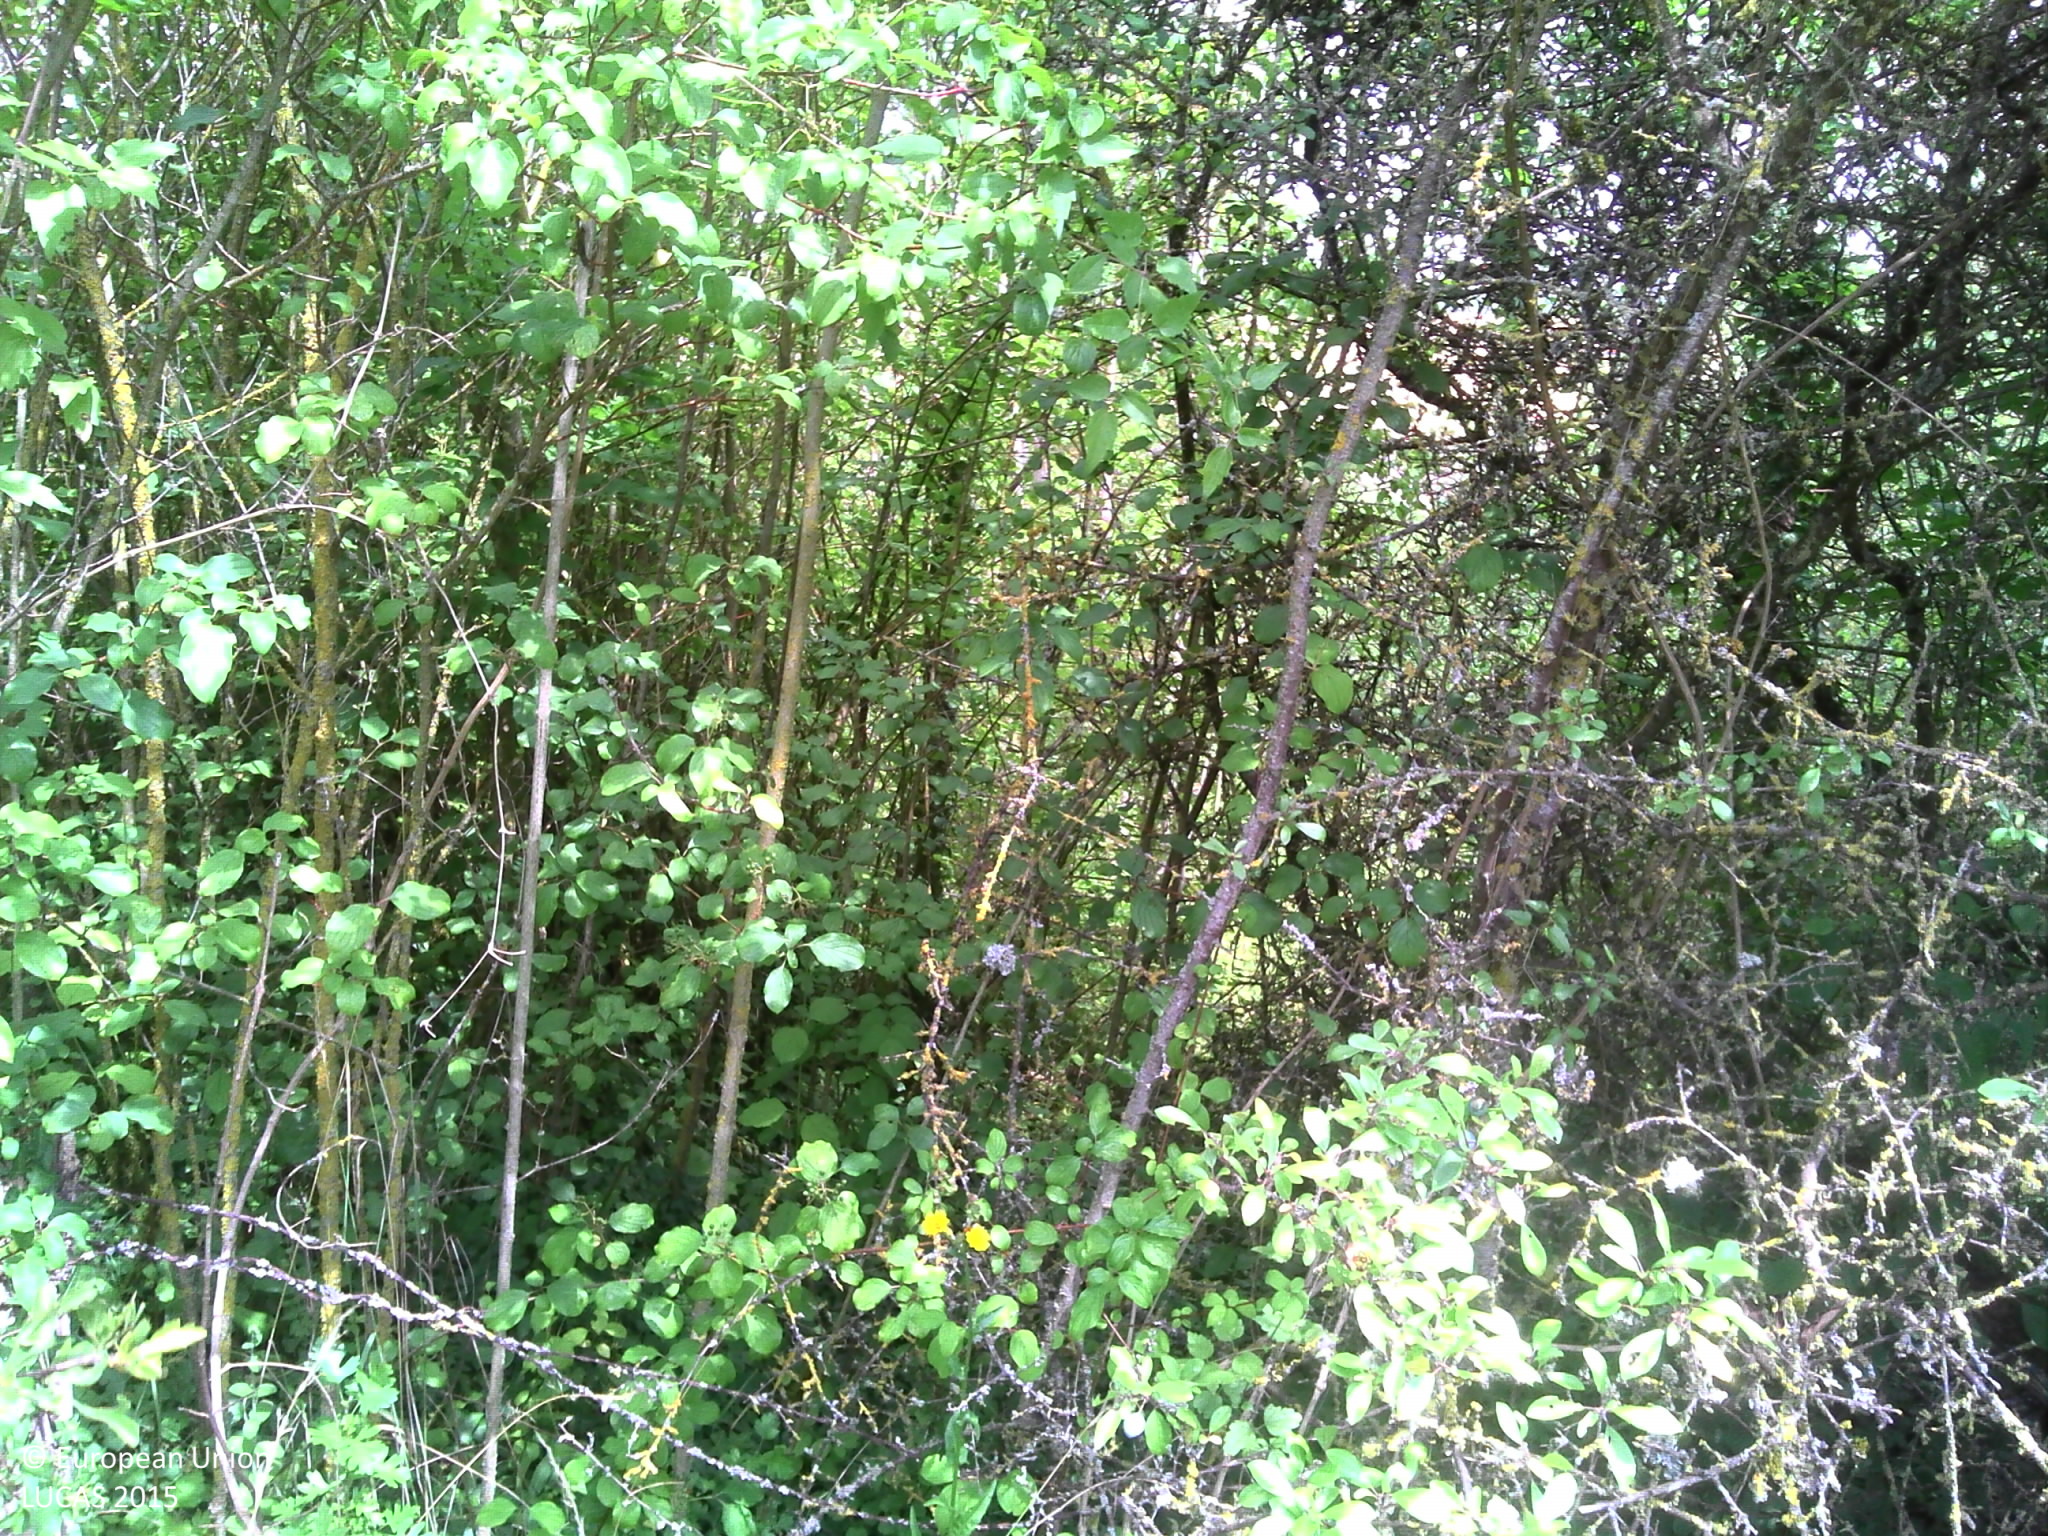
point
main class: Grassland
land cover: Grassland with sparse tree/shrub cover
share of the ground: > 75 %
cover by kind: herbaceous plants 90 %, broadleaved forest trees 5 %, shrubs 5 %
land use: Agriculture (excluding fallow land and kitchen gardens)
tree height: > 5 m
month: July
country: FR
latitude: 48.2967
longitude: 3.4023
